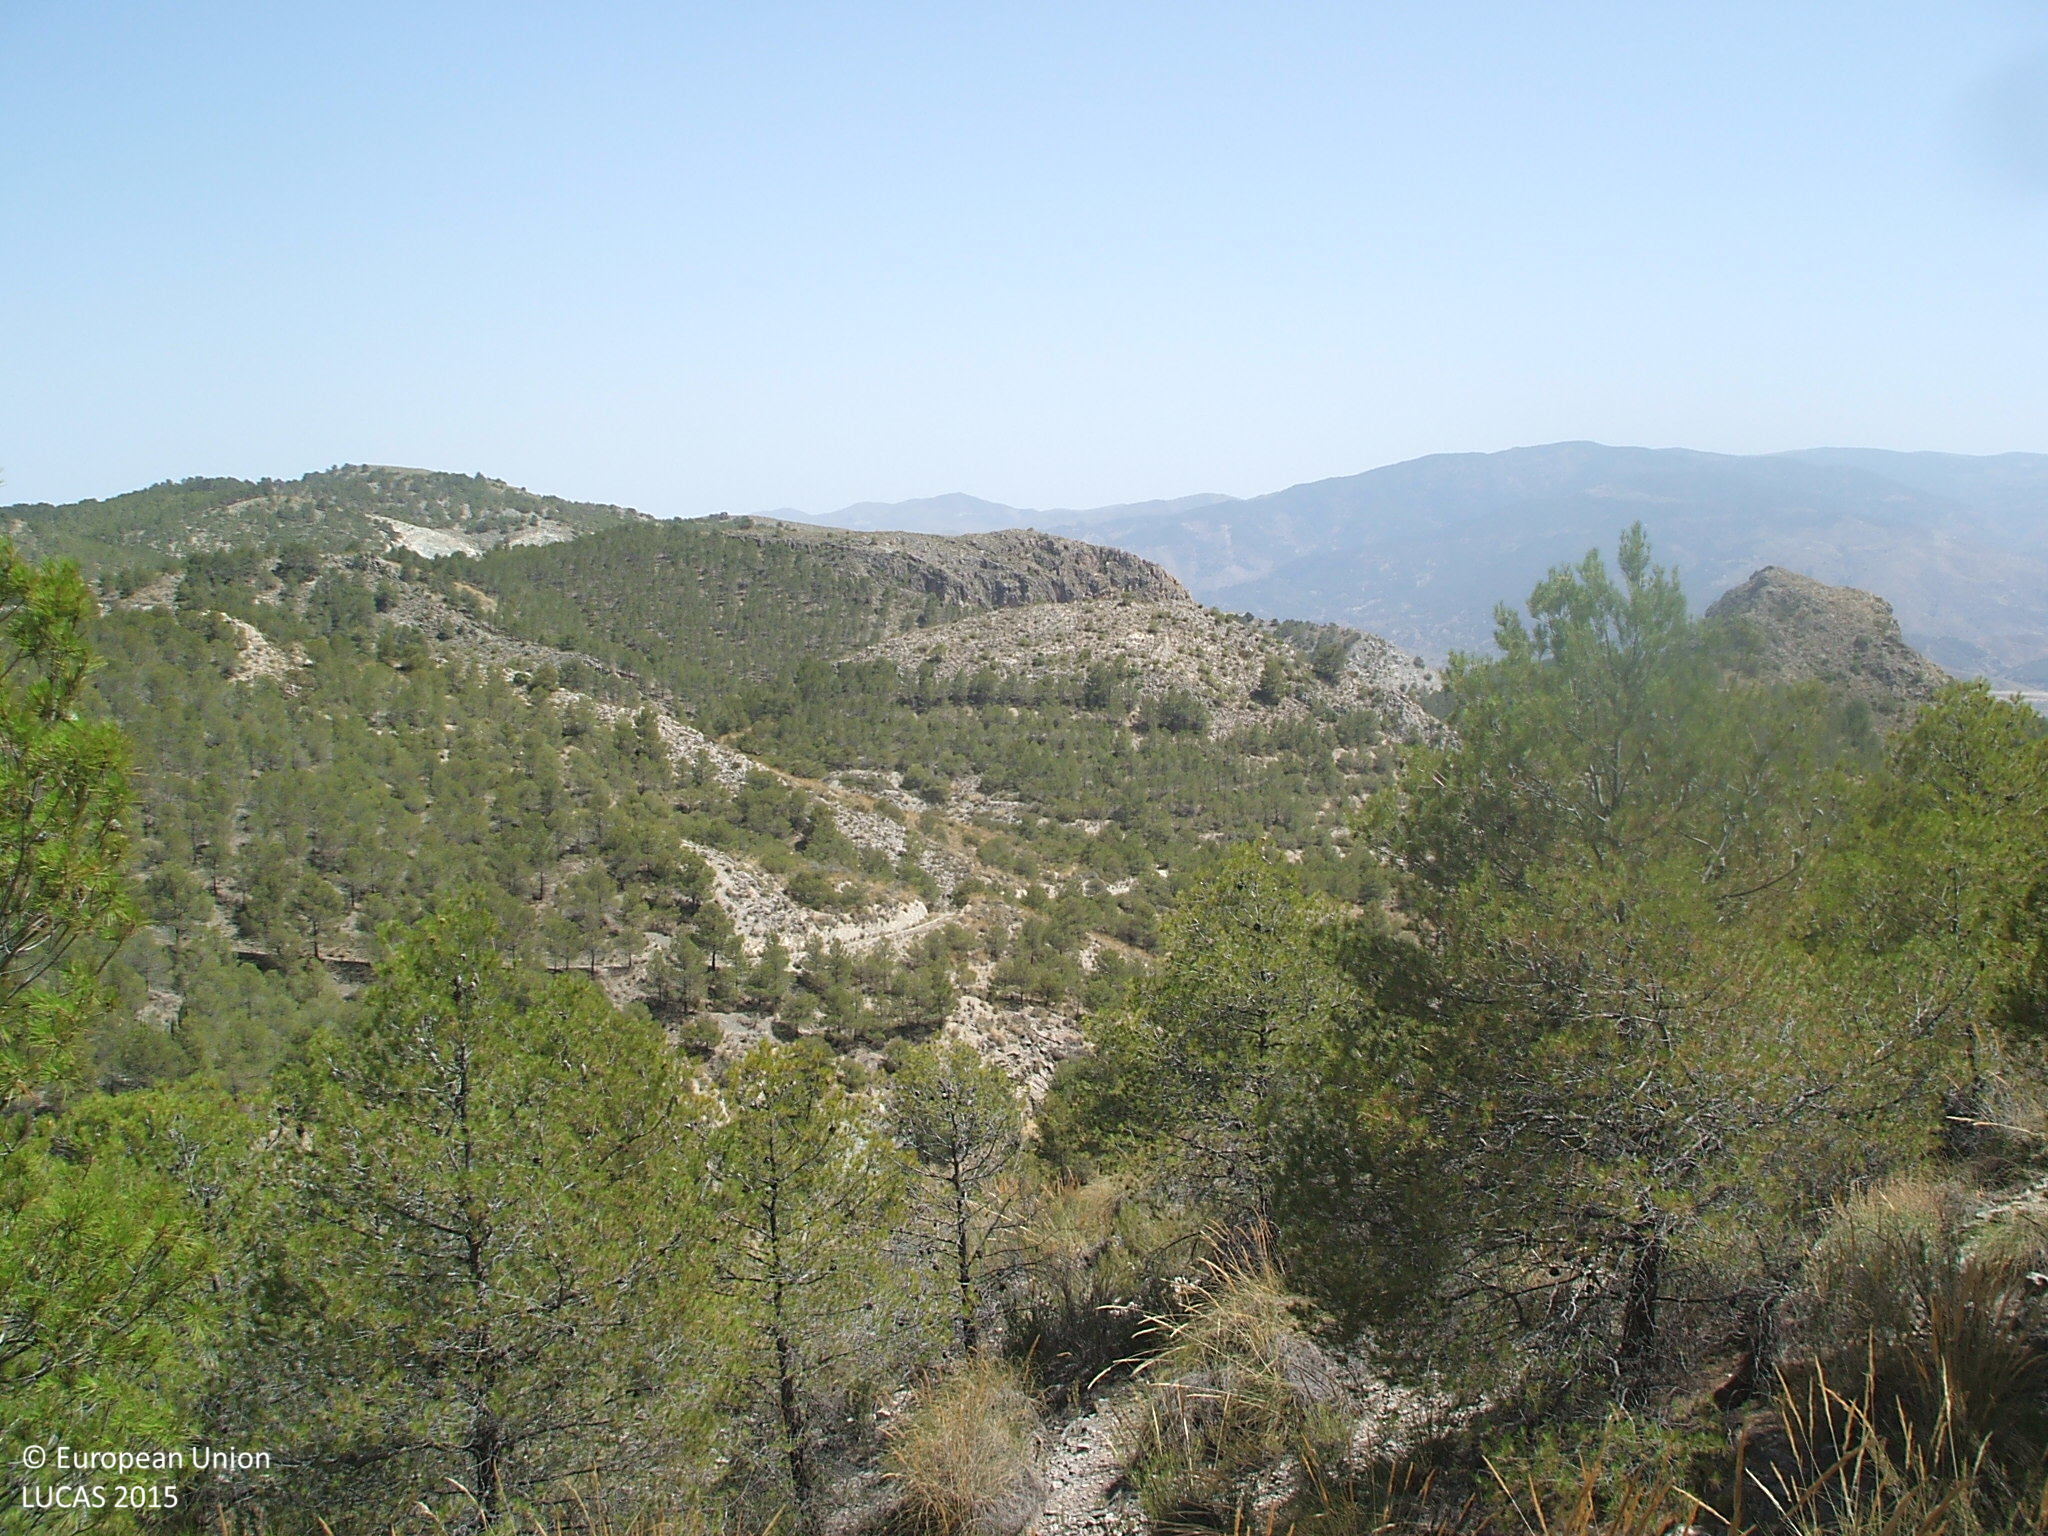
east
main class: Woodland
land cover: Pine dominated coniferous woodland
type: coniferous forest of the mediterranean region
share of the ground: 50 - 75 %
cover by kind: coniferous forest trees 70 %, consolidated bare surface 30 %
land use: Forestry
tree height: > 5 m
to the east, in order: Pine dominated coniferous woodland; Tracks; Pine dominated coniferous woodland
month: July
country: ES
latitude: 37.4091
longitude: -2.3995
